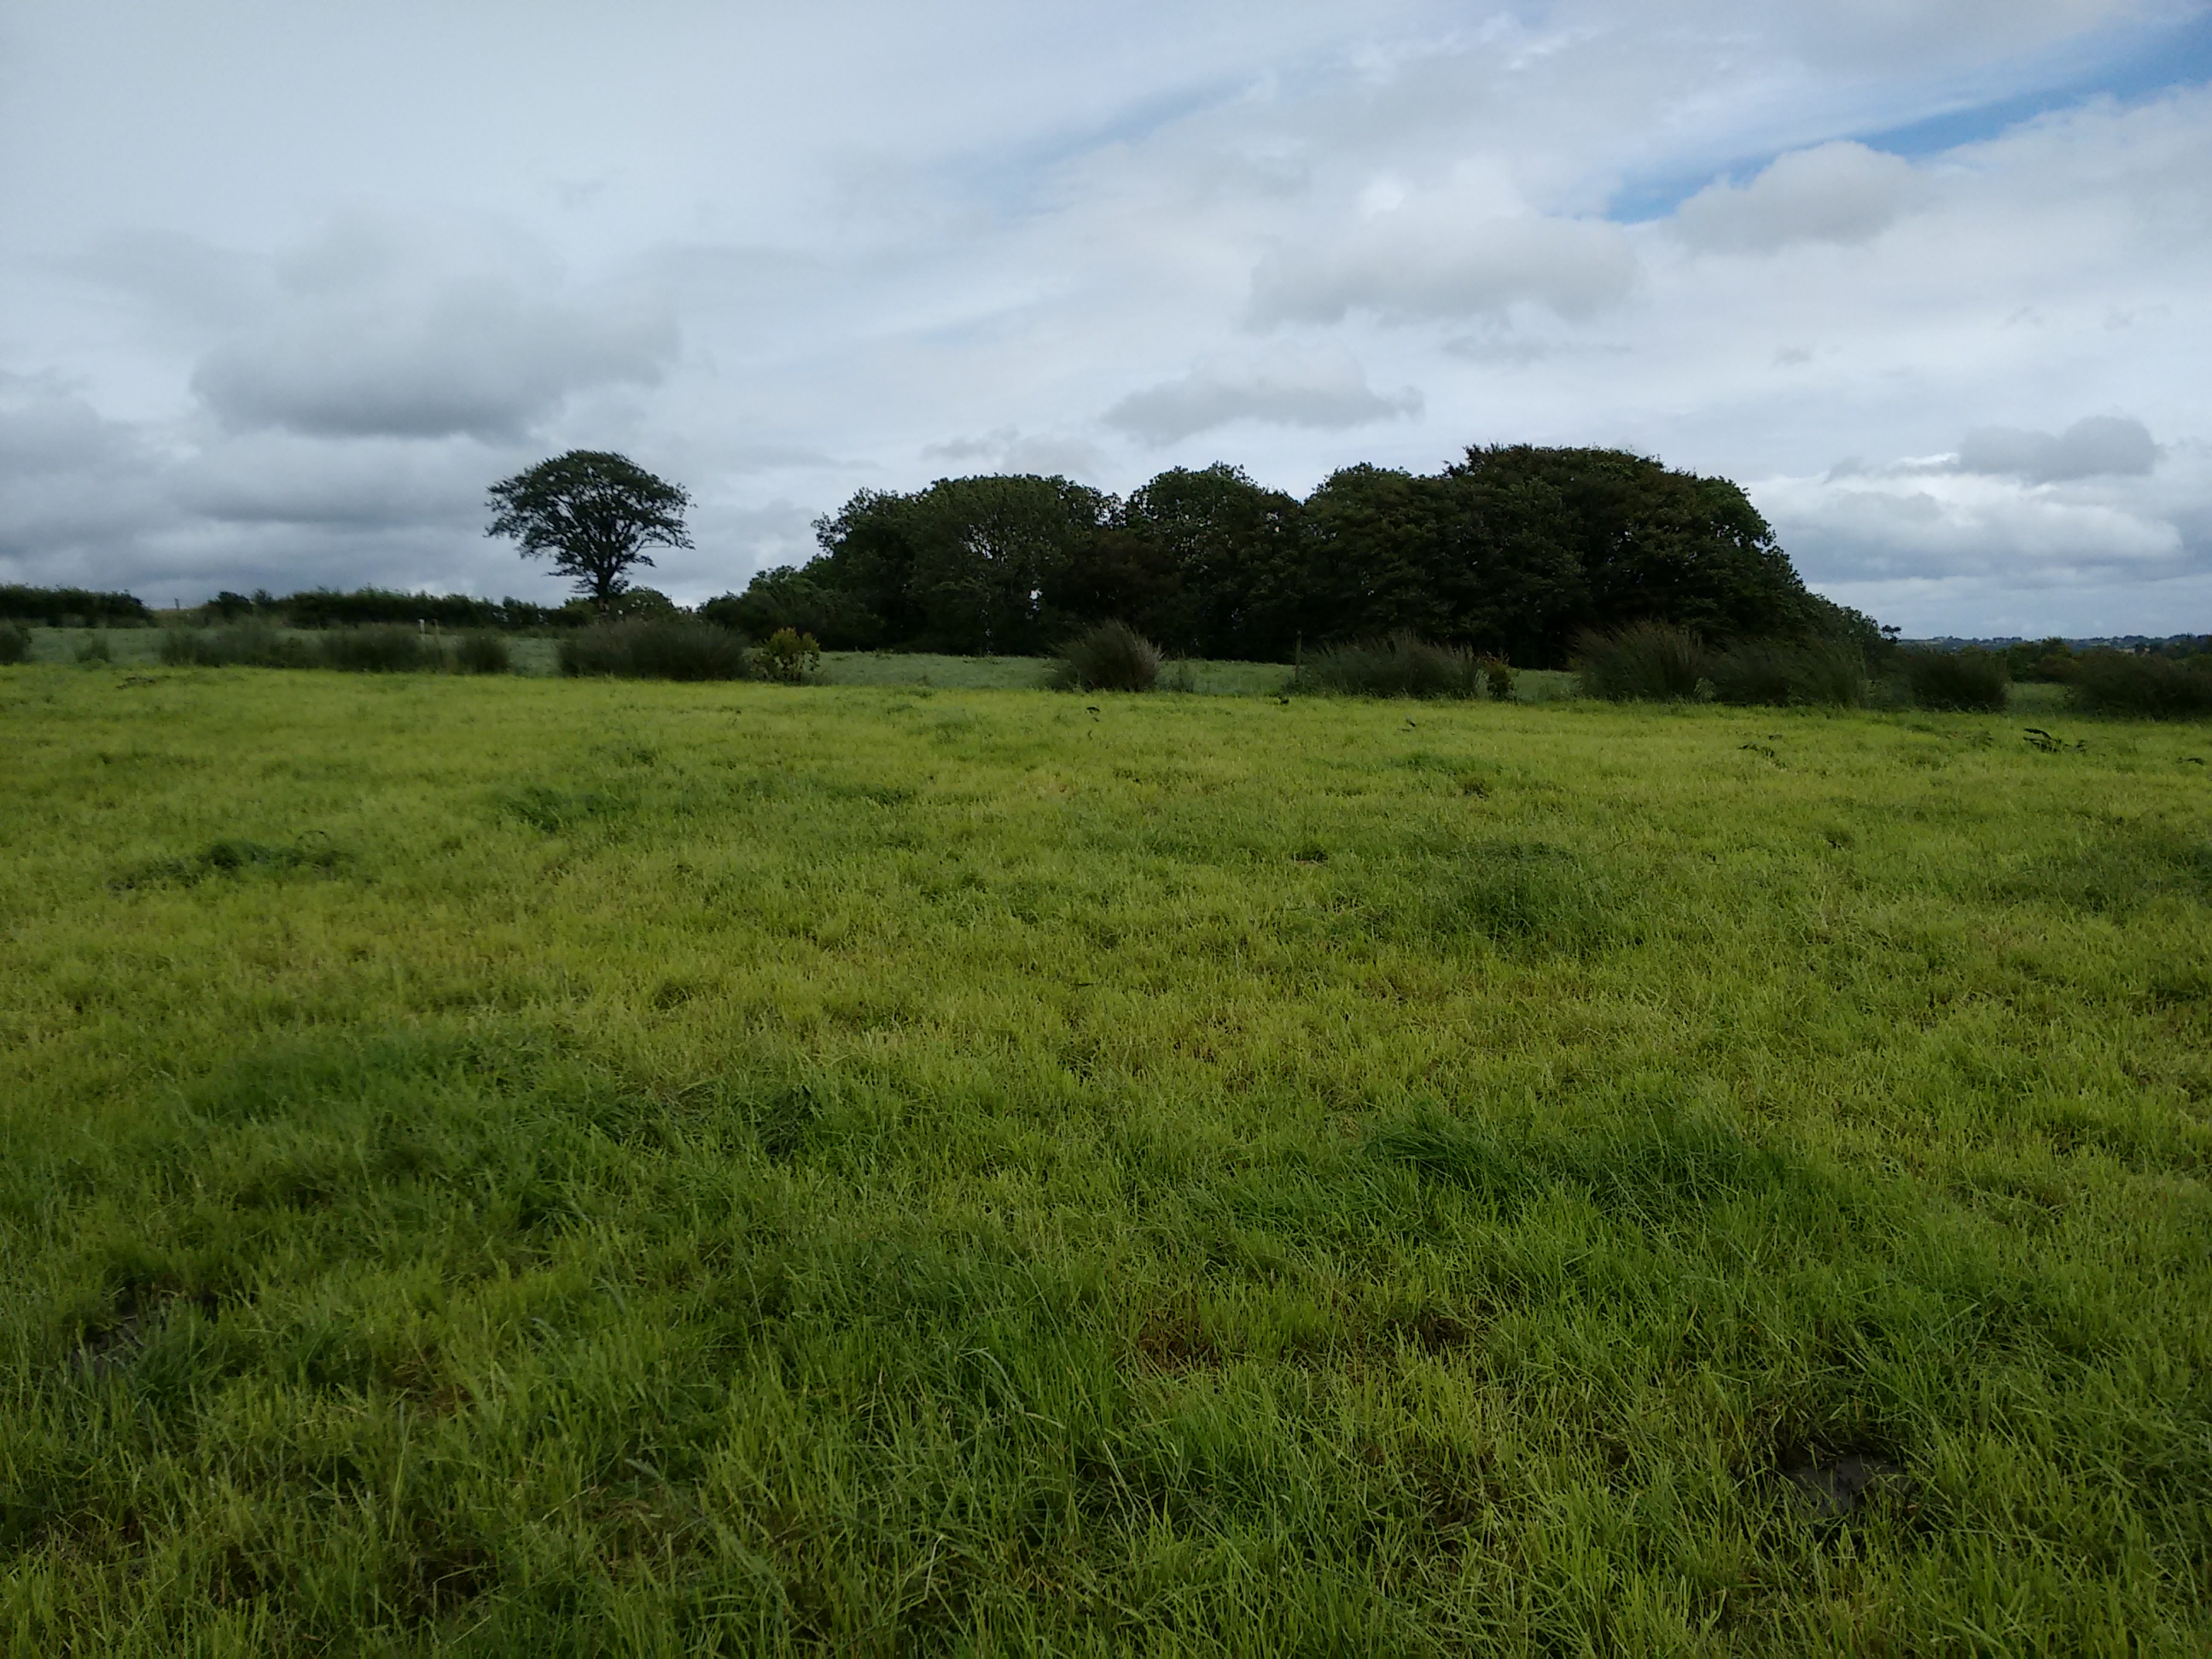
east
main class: Grassland
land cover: Grassland without tree/shrub cover
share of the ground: > 75 %
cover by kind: herbaceous plants 100 %
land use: Agriculture (excluding fallow land and kitchen gardens)
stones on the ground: < 10 %
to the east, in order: Grassland without tree/shrub cover; Fences; Broadleaved woodland; Fences; Grassland without tree/shrub cover; Ditches and canals; Broadleaved woodland; Fences; Grassland without tree/shrub cover; Fences; Abandoned hedges; Grassland without tree/shrub cover
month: July
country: GB
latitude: 54.4916
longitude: -7.3649
